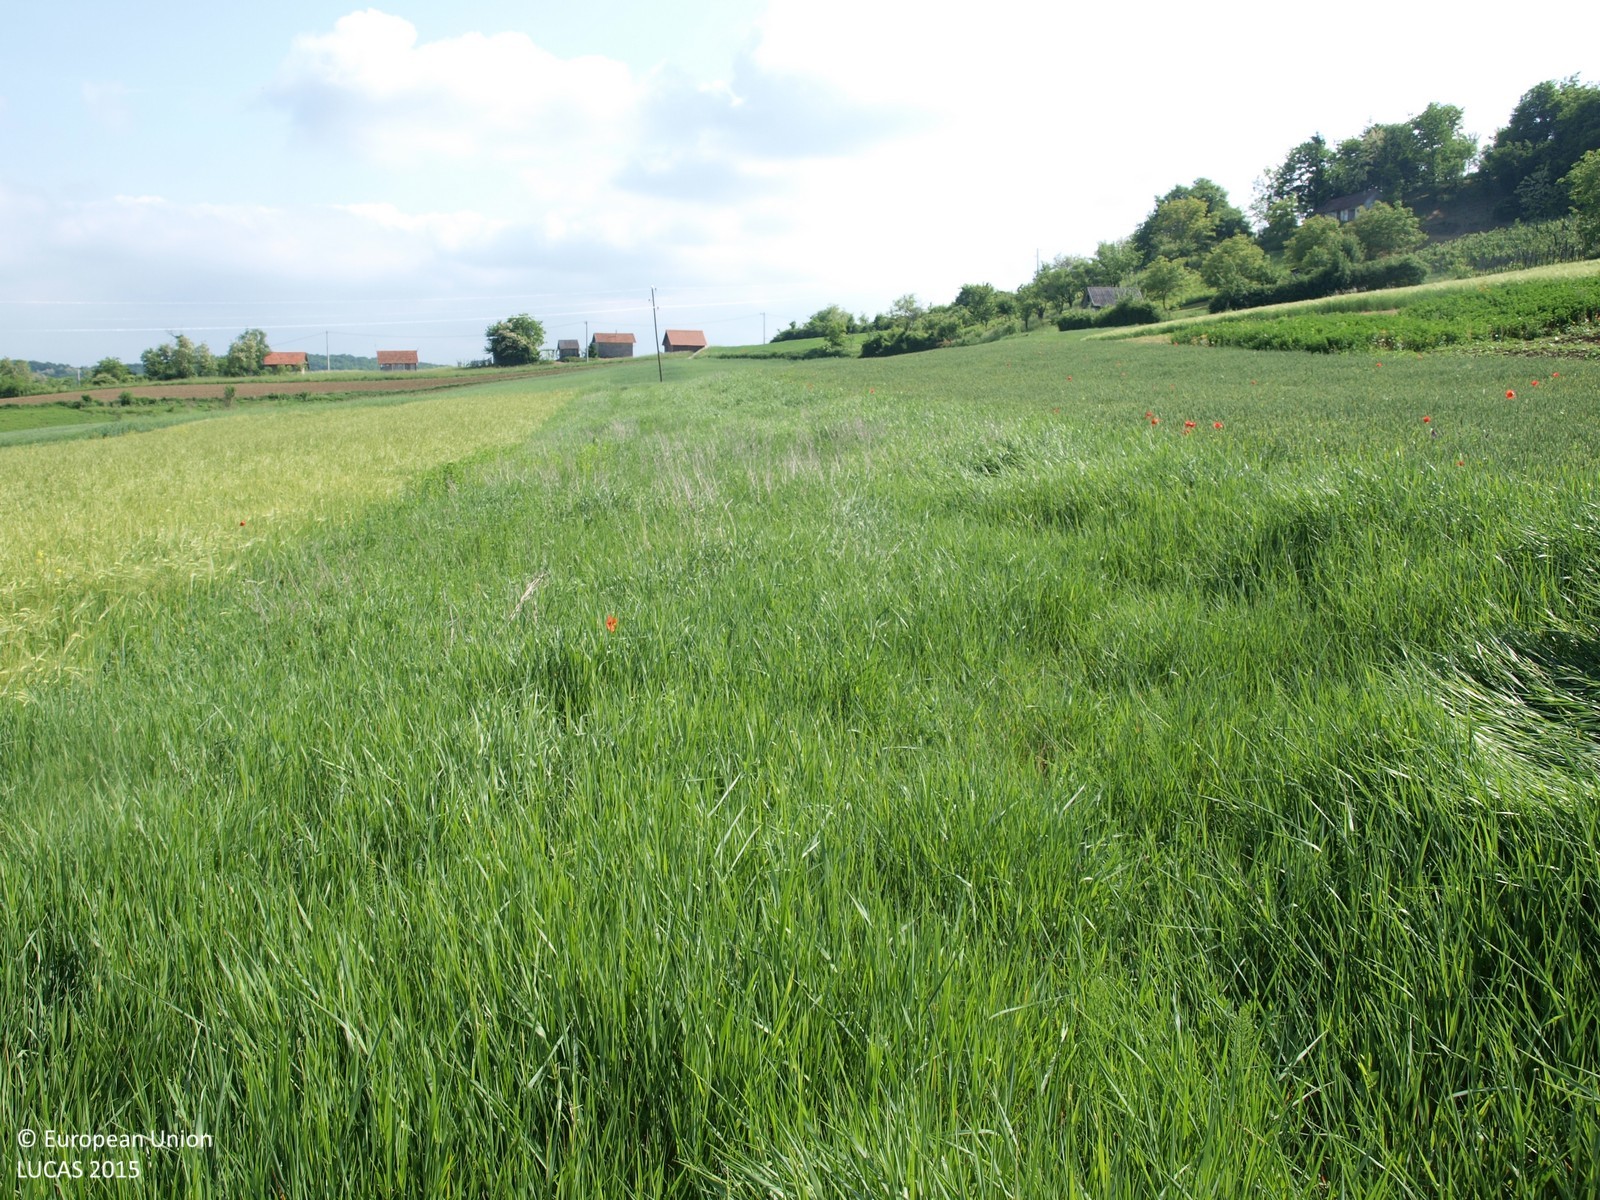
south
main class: Grassland
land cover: Grassland without tree/shrub cover
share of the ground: > 75 %
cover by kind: herbaceous plants 100 %
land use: Agriculture (excluding fallow land and kitchen gardens)
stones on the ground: < 10 %
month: May
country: HR
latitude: 46.1547
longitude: 16.1757
